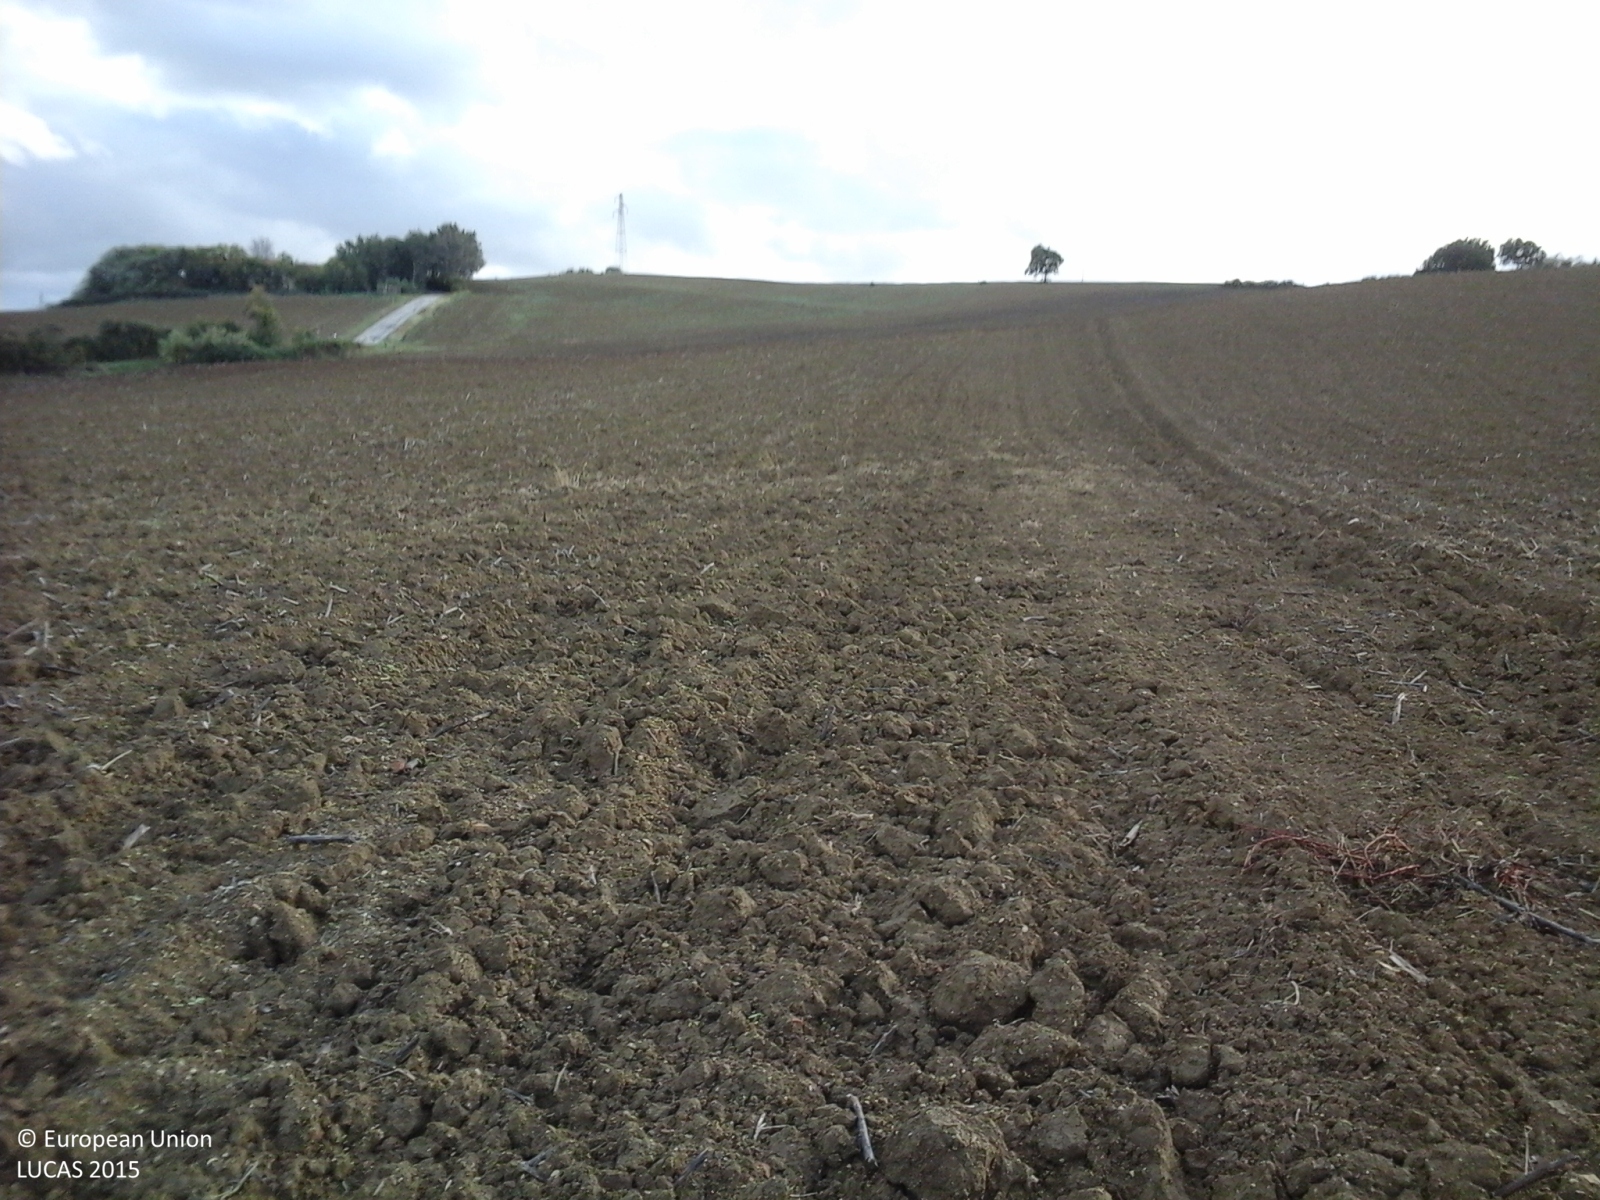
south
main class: Cropland
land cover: Sunflower
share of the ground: < 10 %
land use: Agriculture (excluding fallow land and kitchen gardens)
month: October
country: IT
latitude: 43.6677
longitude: 13.2540
